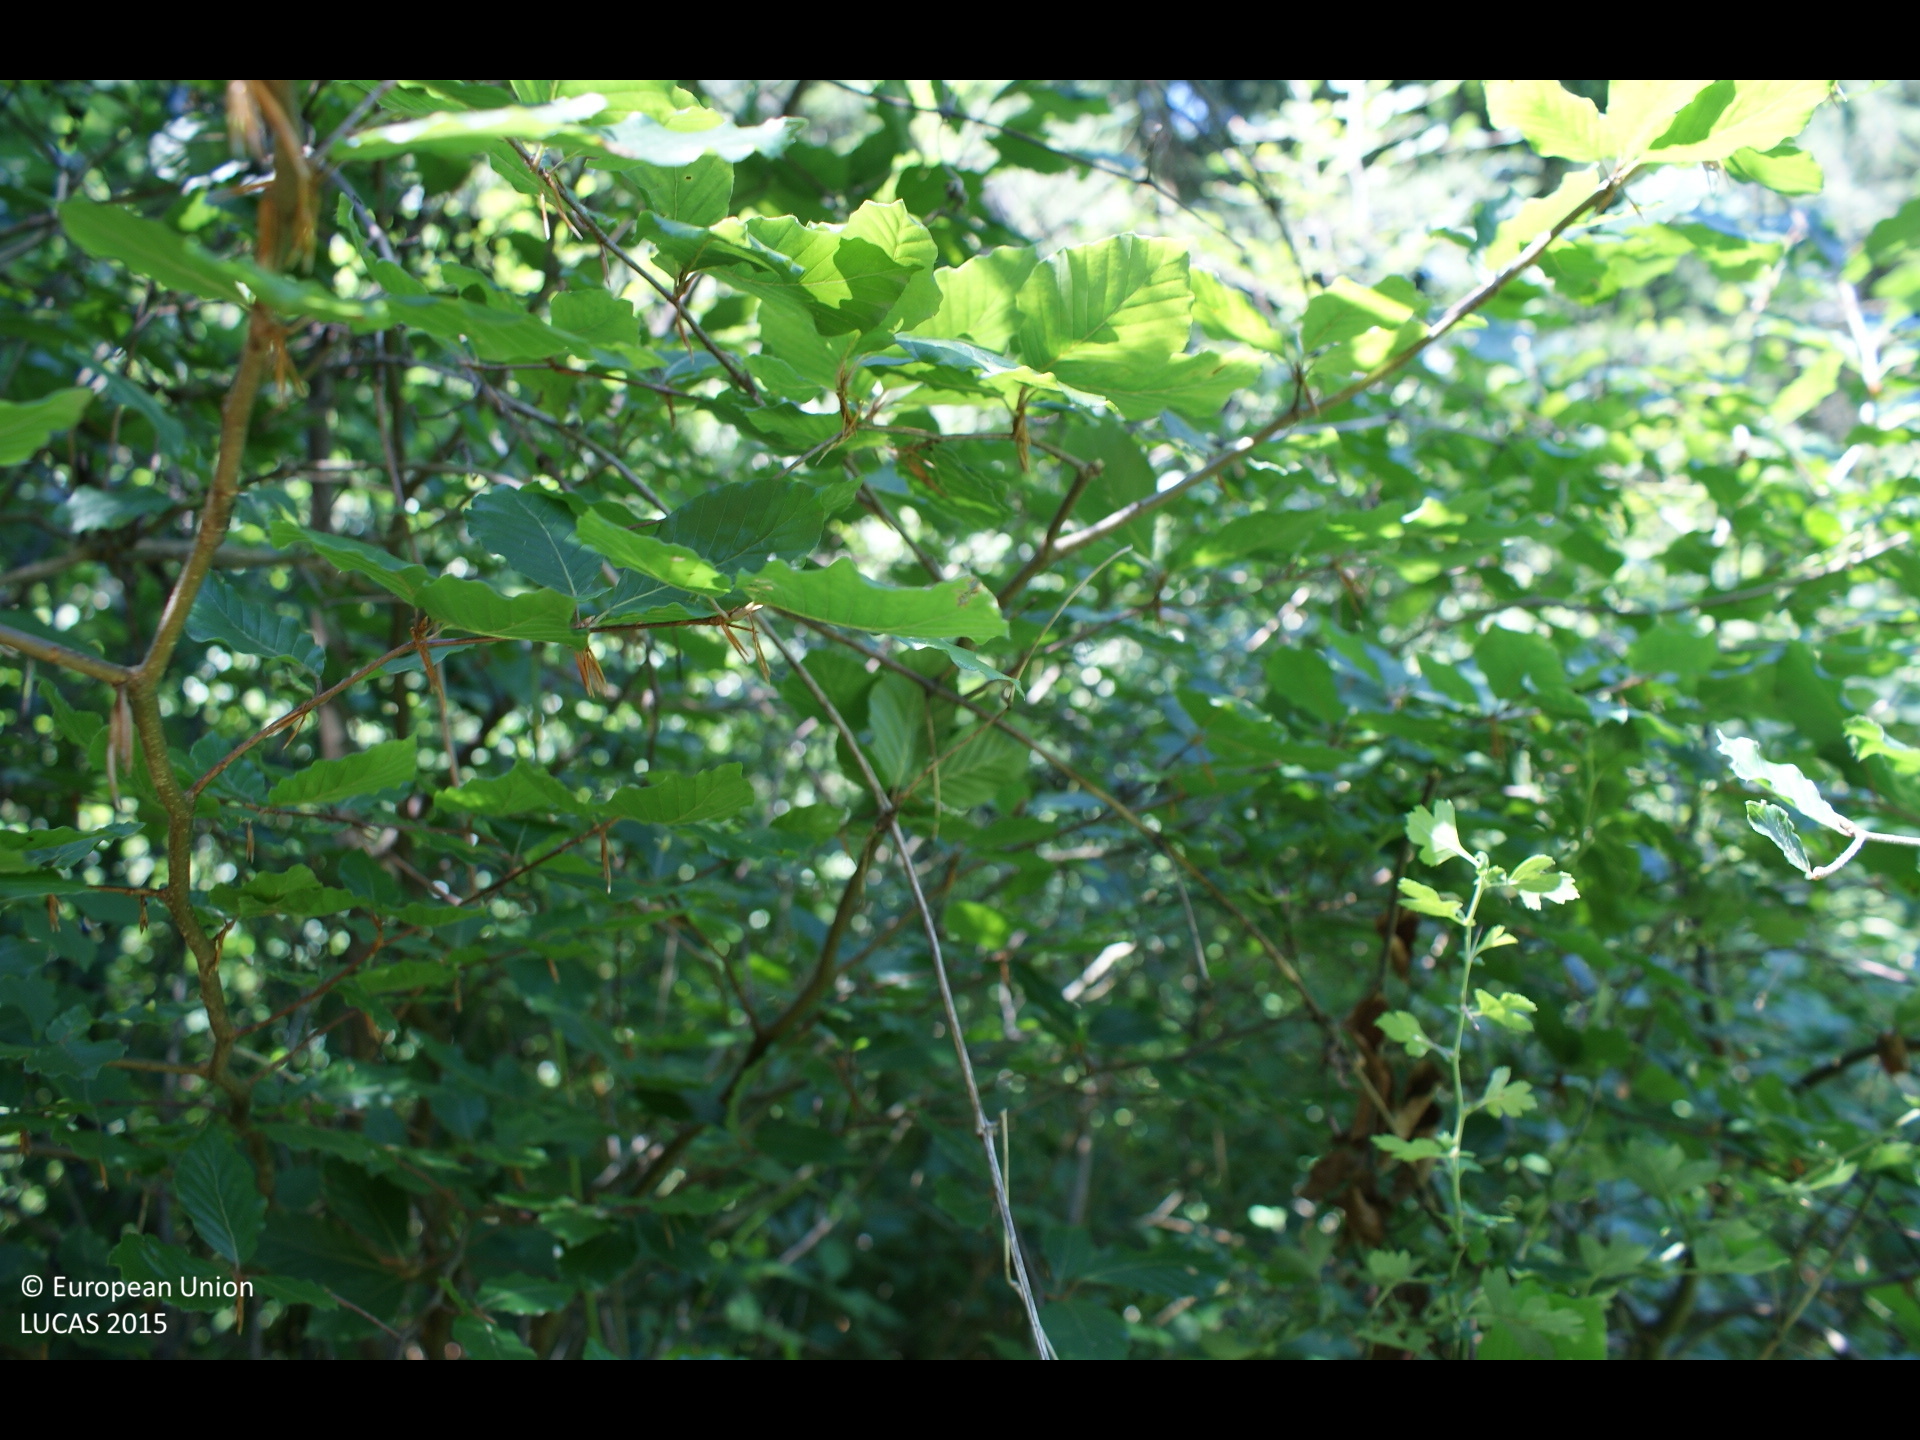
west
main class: Woodland
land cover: Broadleaved woodland
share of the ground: > 75 %
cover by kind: shrubs 40 %, herbaceous plants 30 %, broadleaved forest trees 25 %, coniferous forest trees 5 %
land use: Forestry
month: July
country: AT
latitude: 47.9523
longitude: 15.2905
